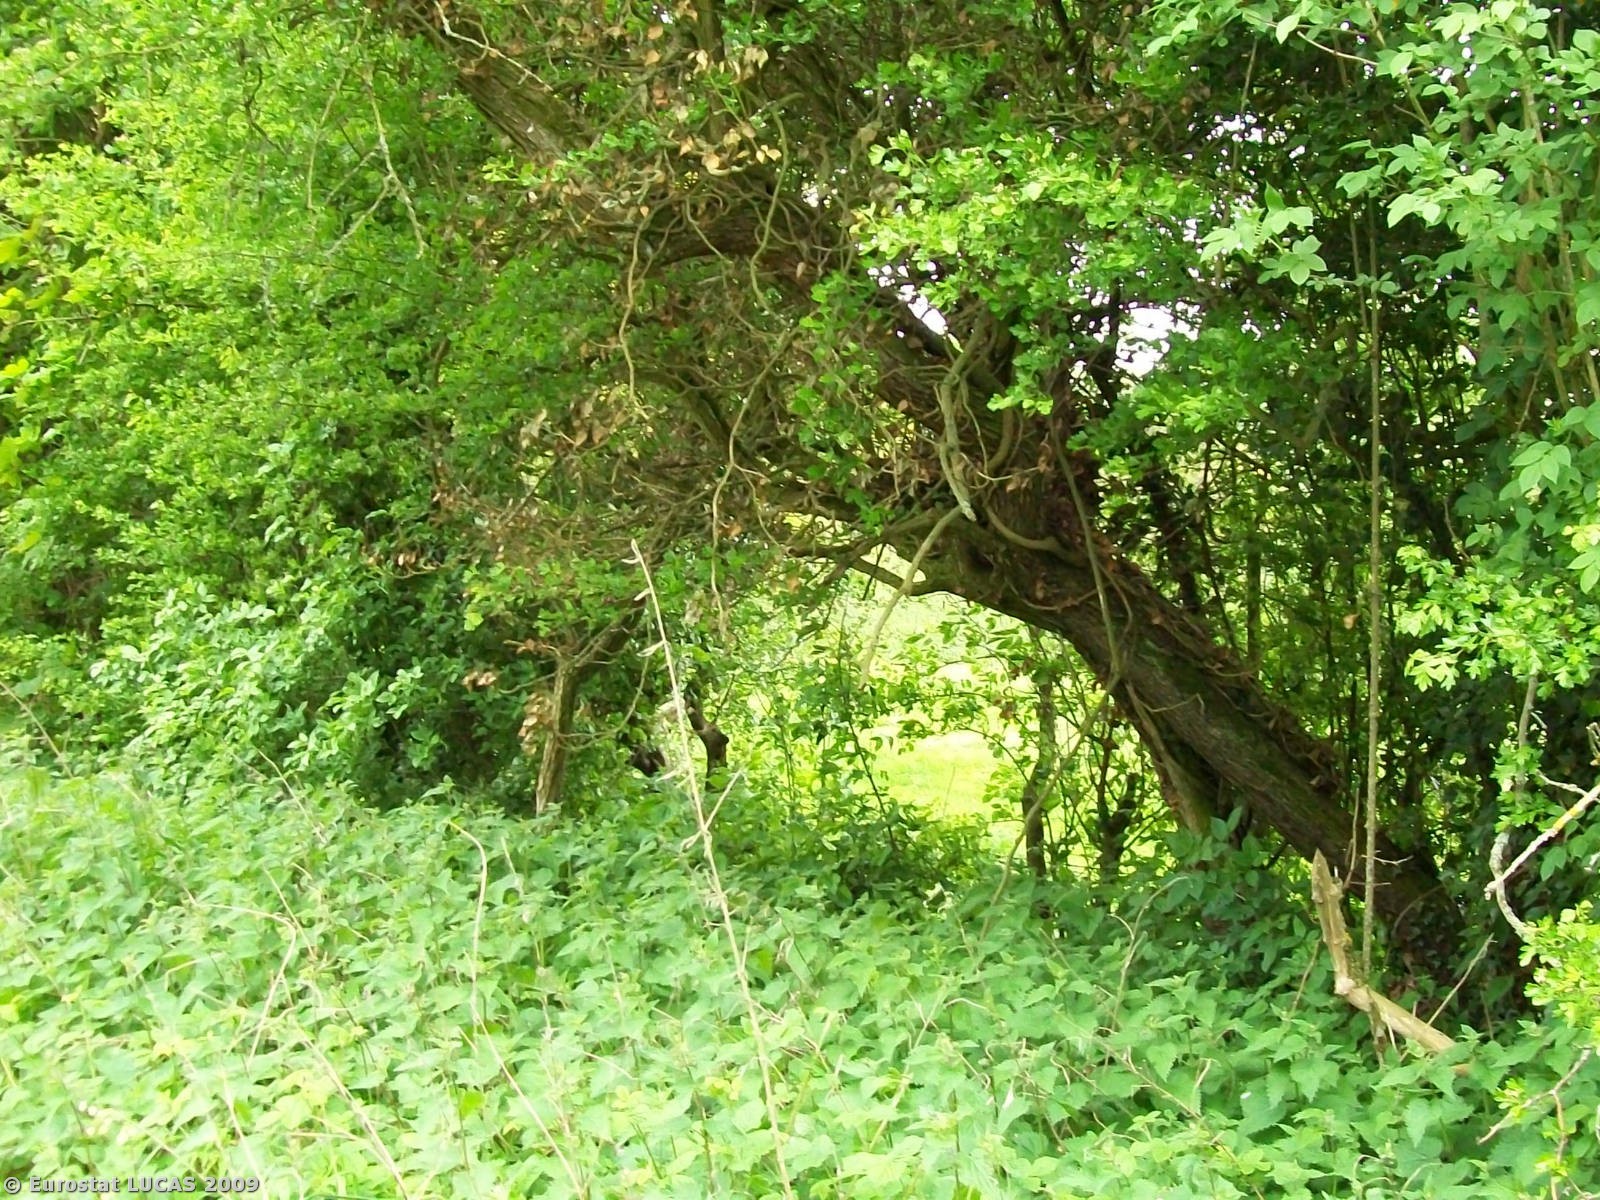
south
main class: Woodland
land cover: Broadleaved woodland
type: mesophytic deciduous forest
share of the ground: 25 - 50 %
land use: Unused
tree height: > 5 m
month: May
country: GB
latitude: 52.3359
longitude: -2.4671
